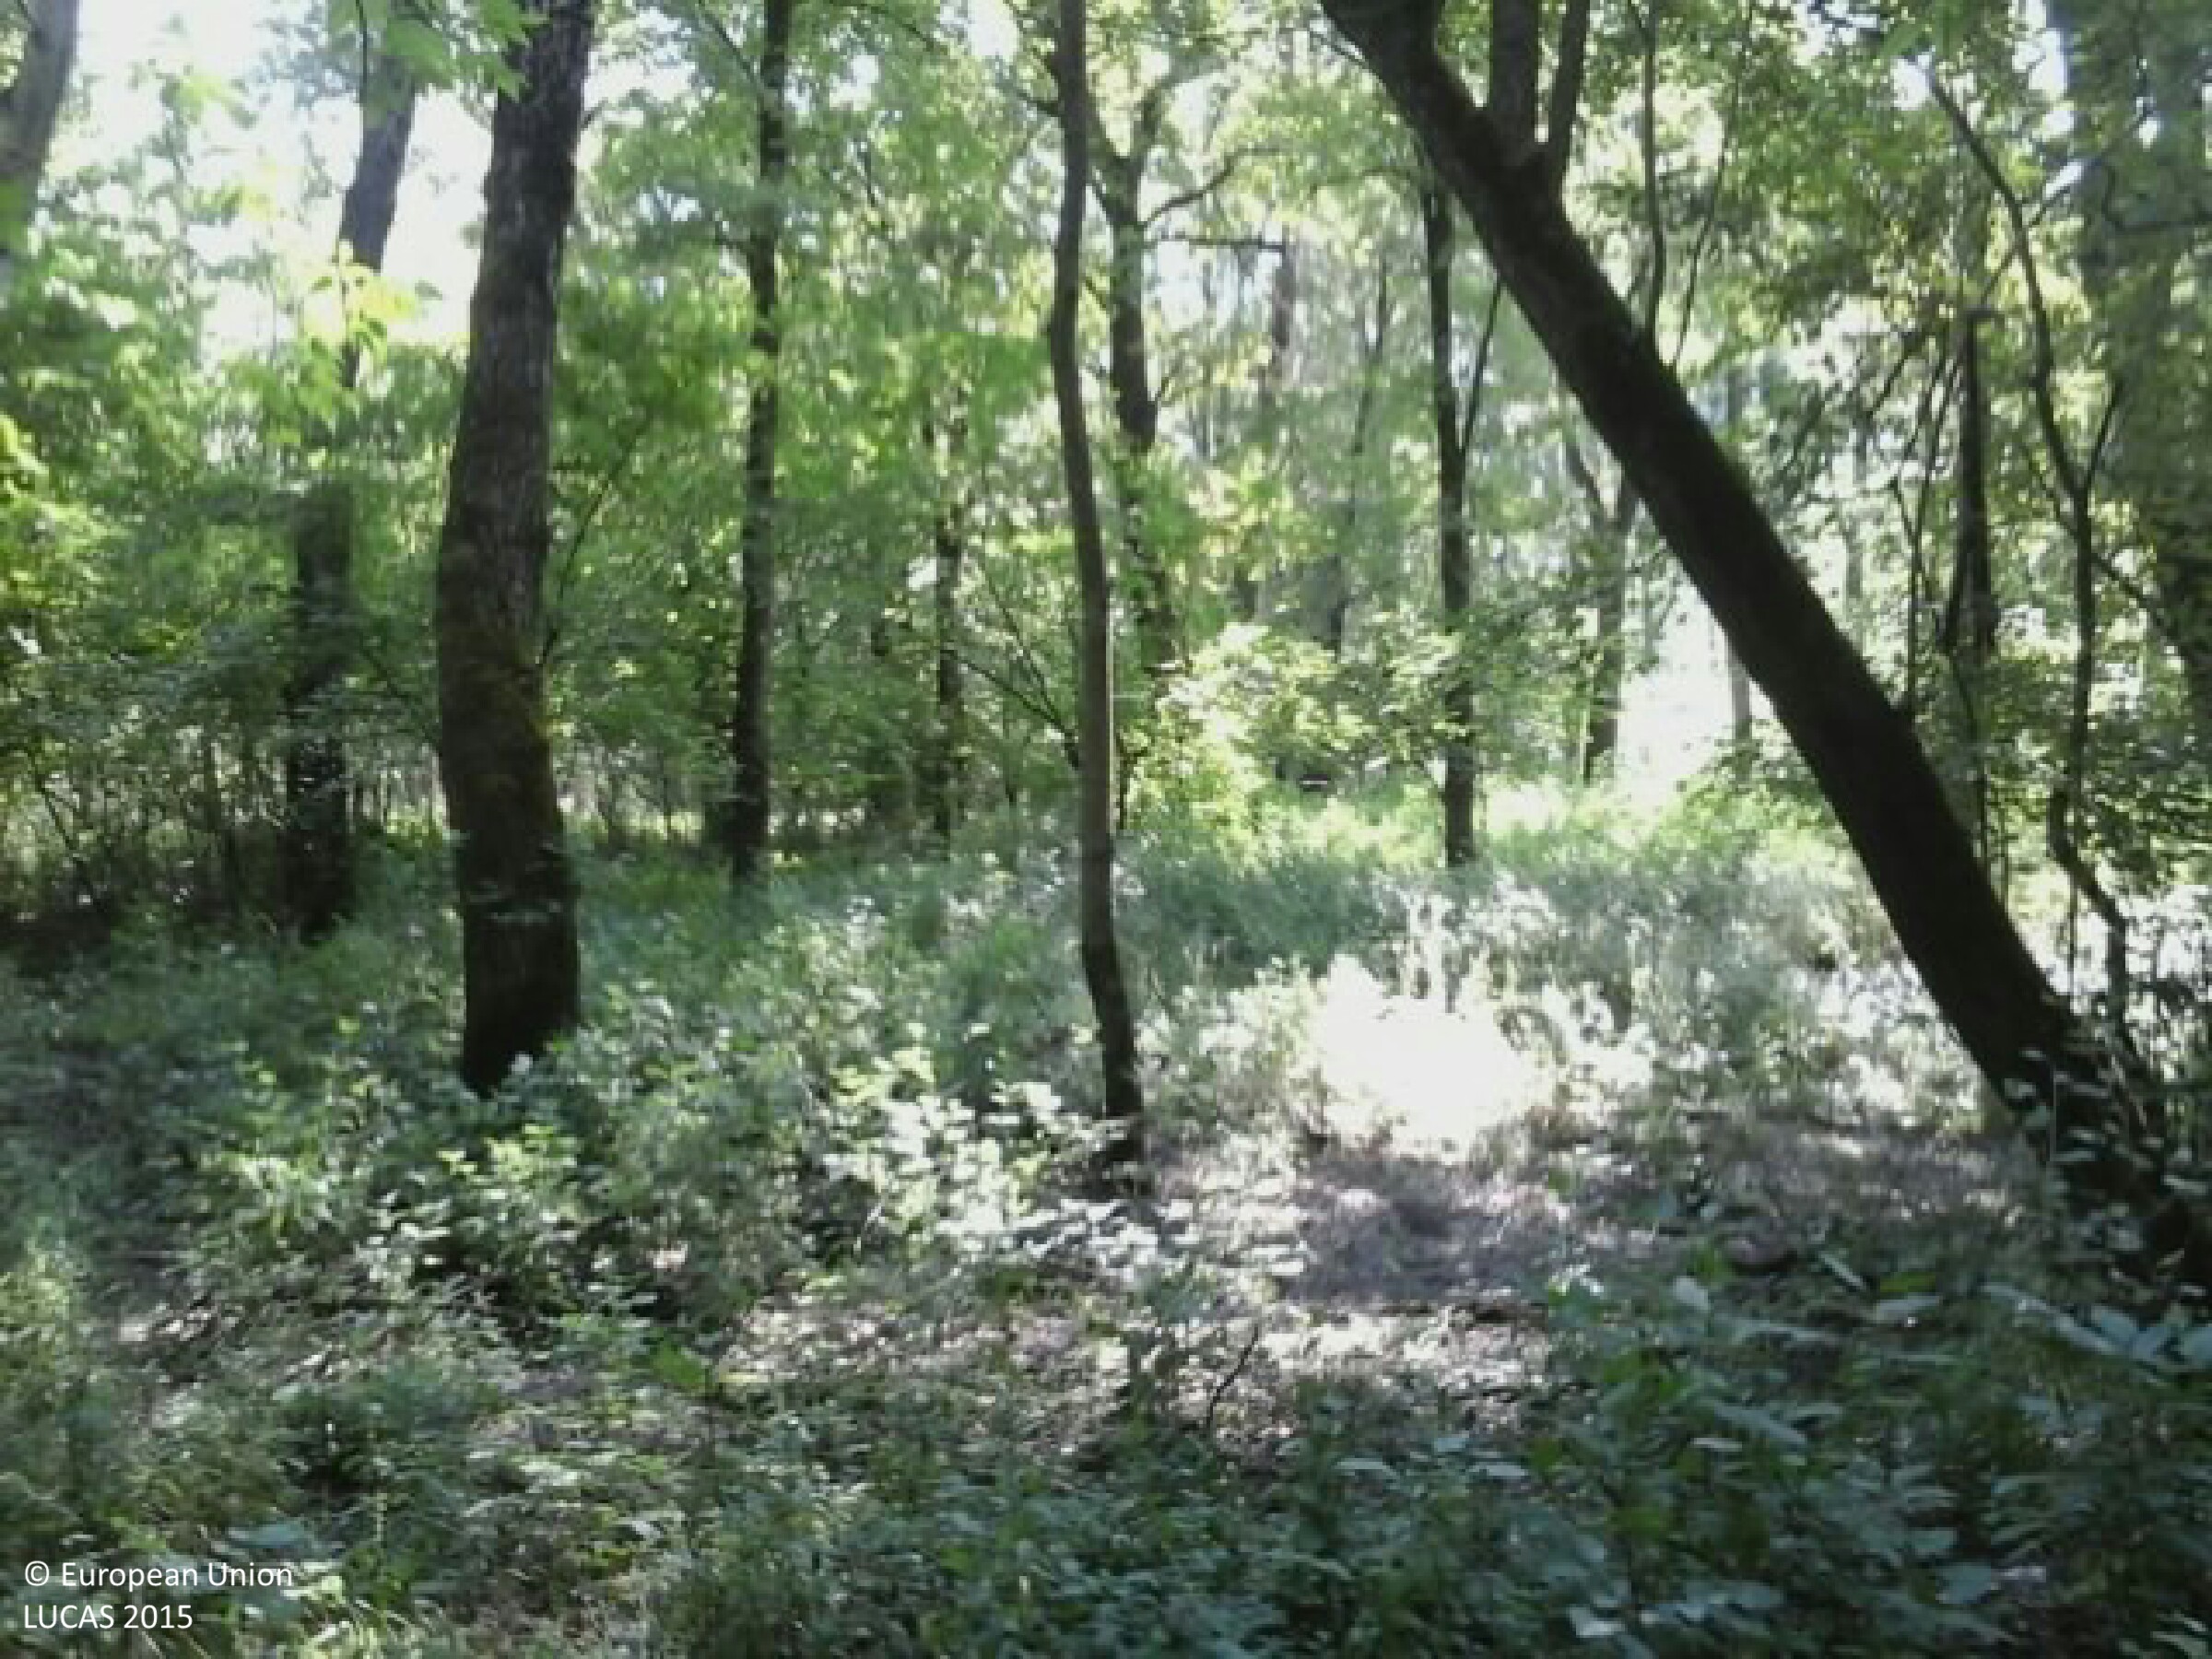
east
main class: Woodland
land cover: Broadleaved woodland
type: exotic forest
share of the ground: > 75 %
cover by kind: broadleaved forest trees 80 %, herbaceous plants 15 %, shrubs 5 %
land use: Forestry
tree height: > 5 m
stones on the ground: < 10 %
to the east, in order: Broadleaved woodland; Spontaneously vegetated surfaces; Fences; Broadleaved woodland; Fences; Grass margins; Tracks; Grass margins; Broadleaved woodland; Grass margins; Tracks
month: July
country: HU
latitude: 46.1487
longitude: 18.8281
